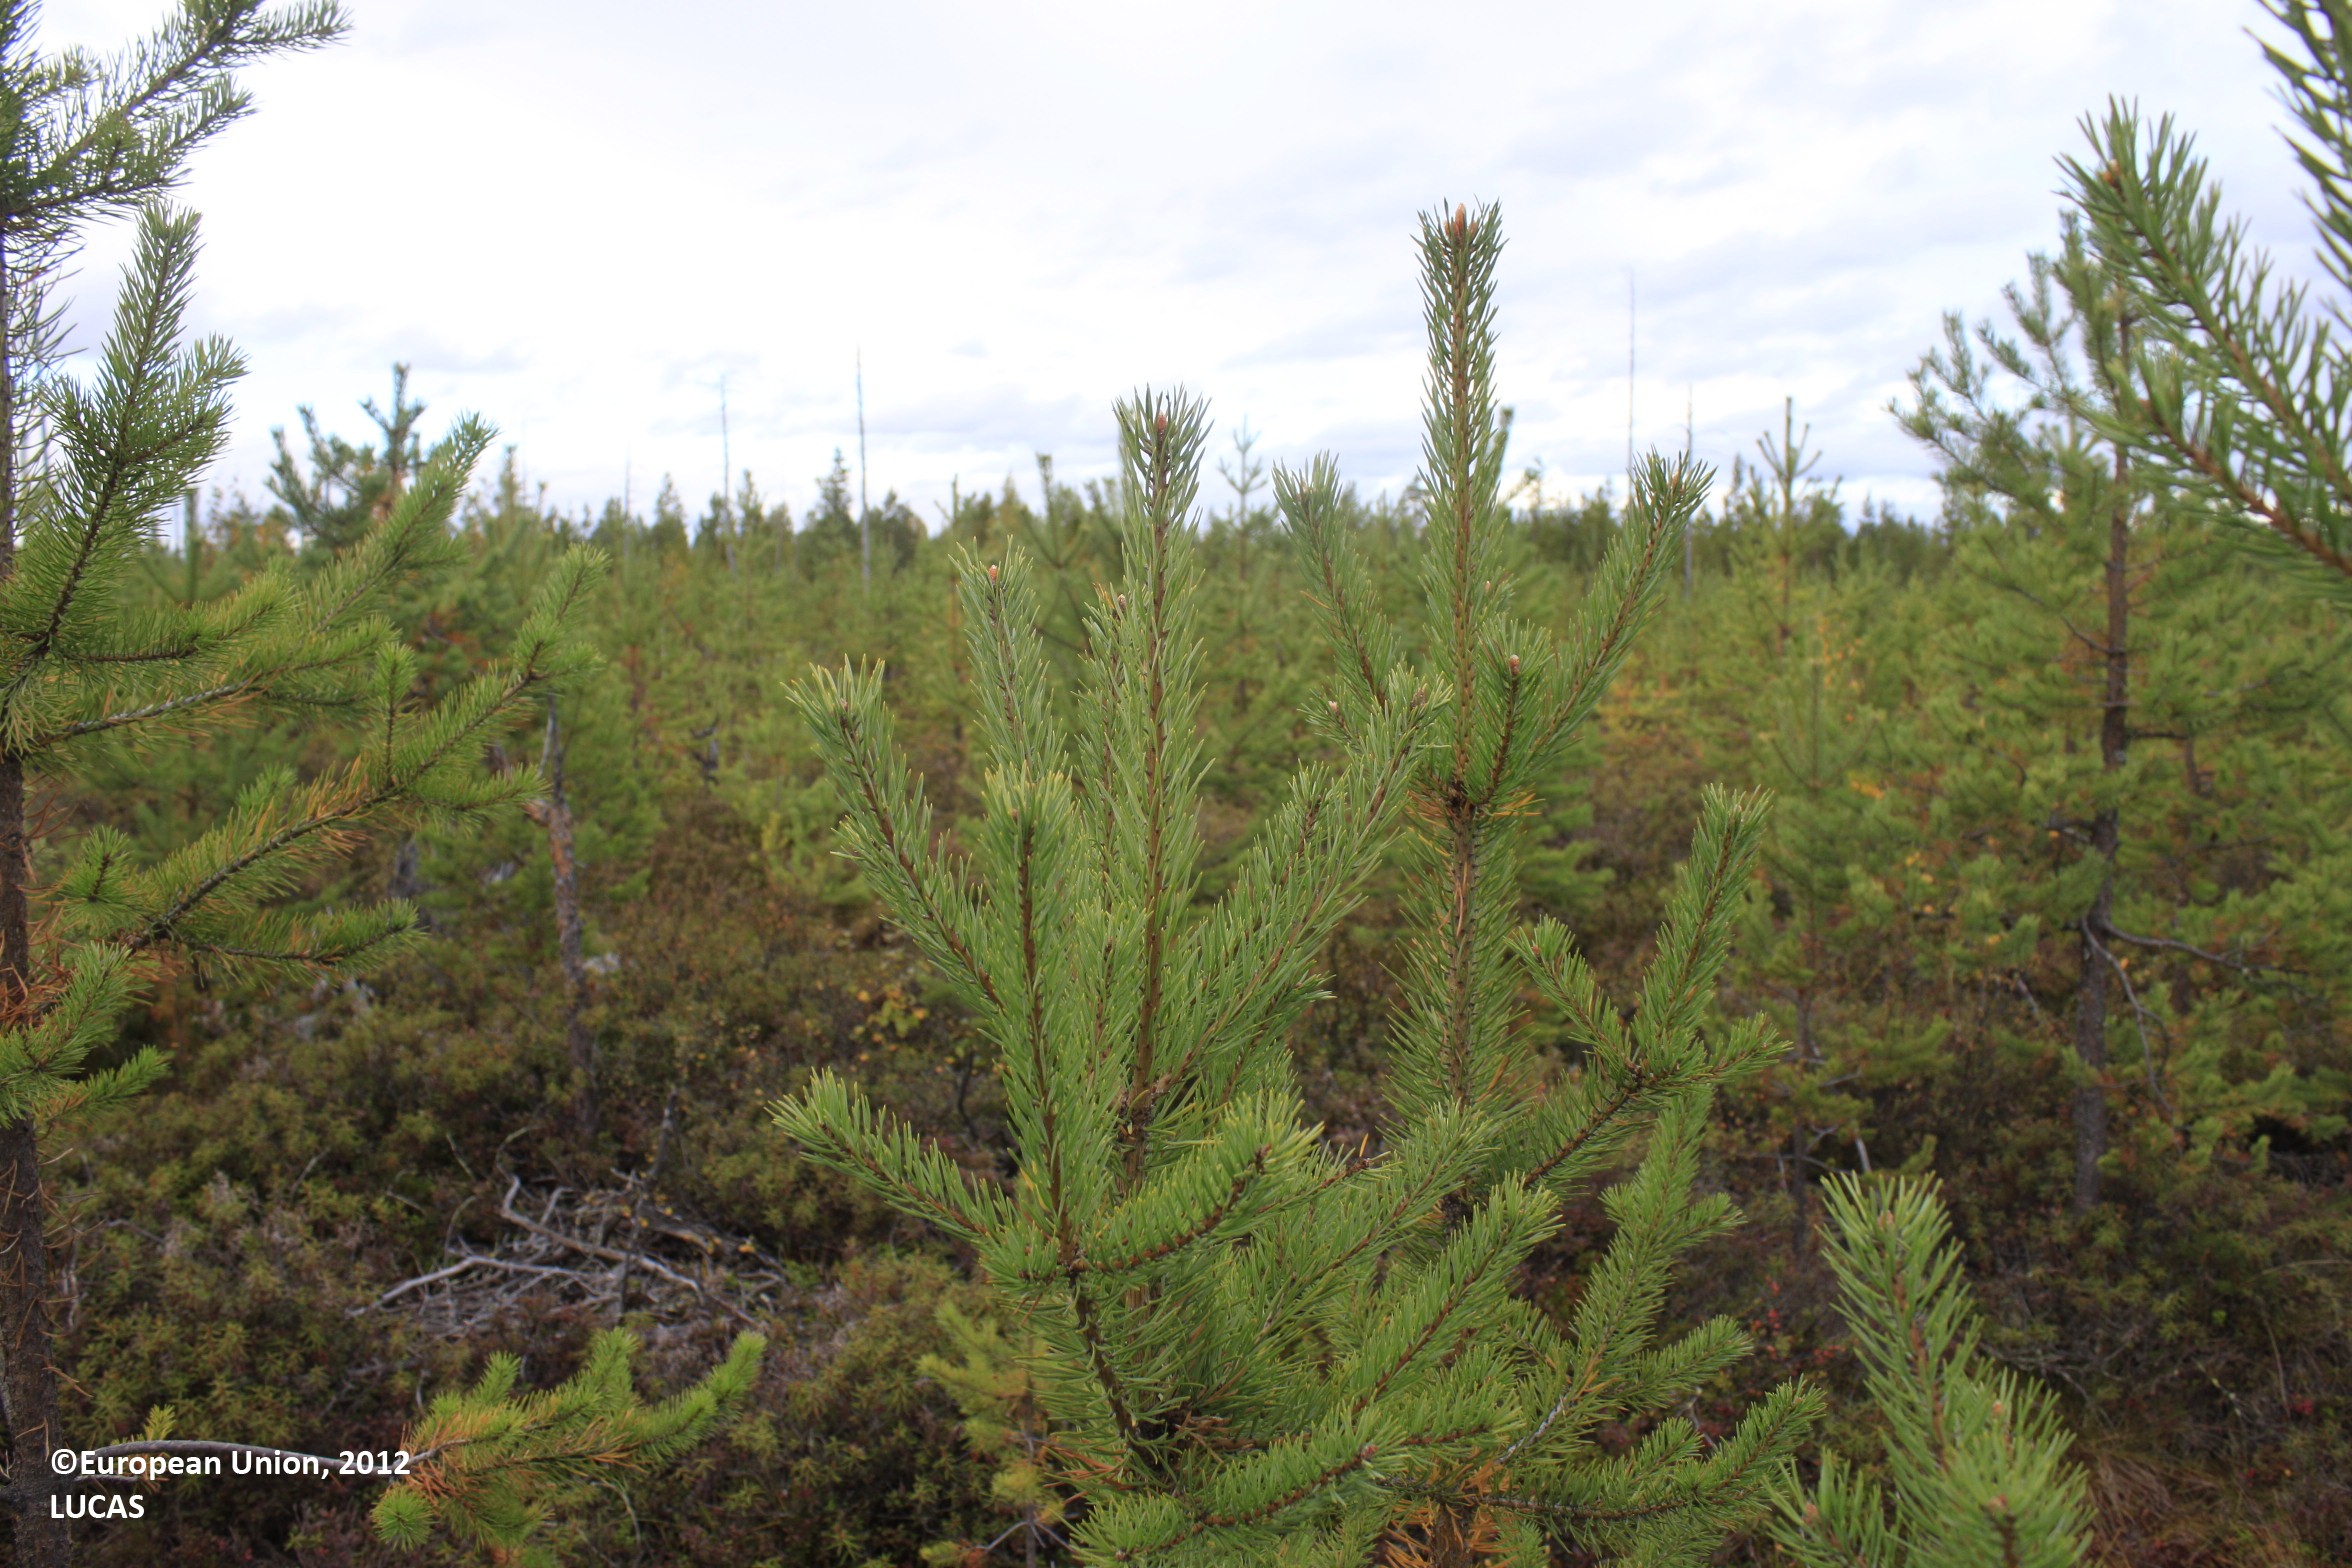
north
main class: Woodland
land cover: Pine dominated coniferous woodland
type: boreal forest
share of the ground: 50 - 75 %
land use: Forestry
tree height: < 5 m
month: September
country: FI
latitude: 65.4320
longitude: 27.0820
